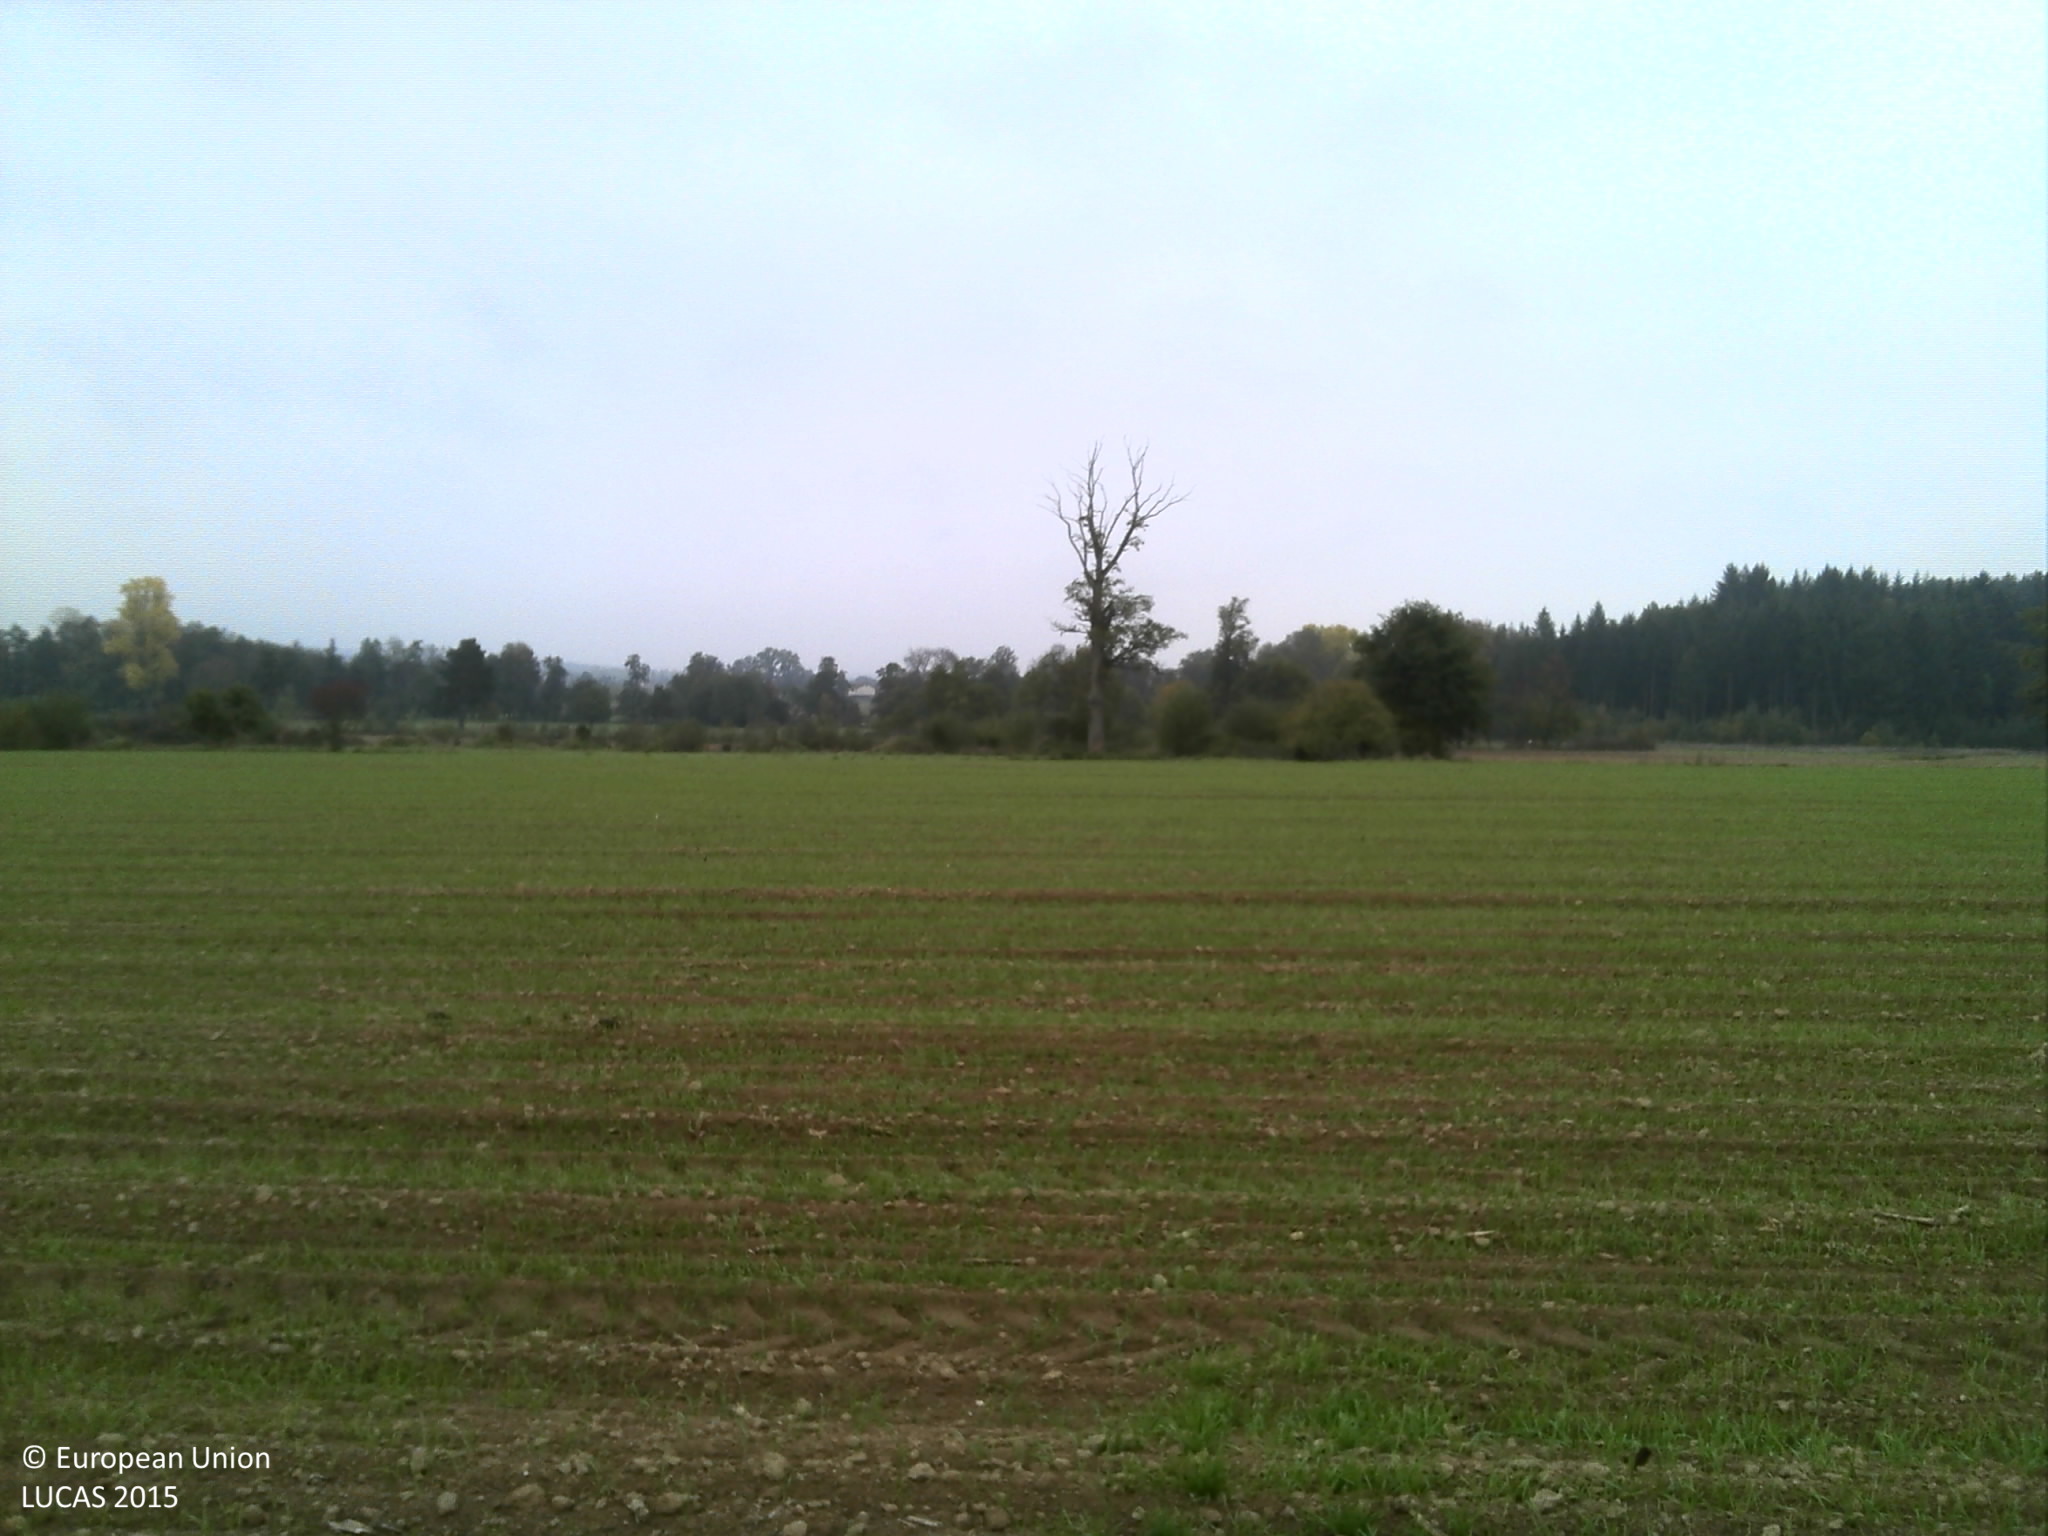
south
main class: Cropland
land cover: Common wheat
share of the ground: 25 - 50 %
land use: Agriculture (excluding fallow land and kitchen gardens)
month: October
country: FR
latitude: 45.4981
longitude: 3.7189
